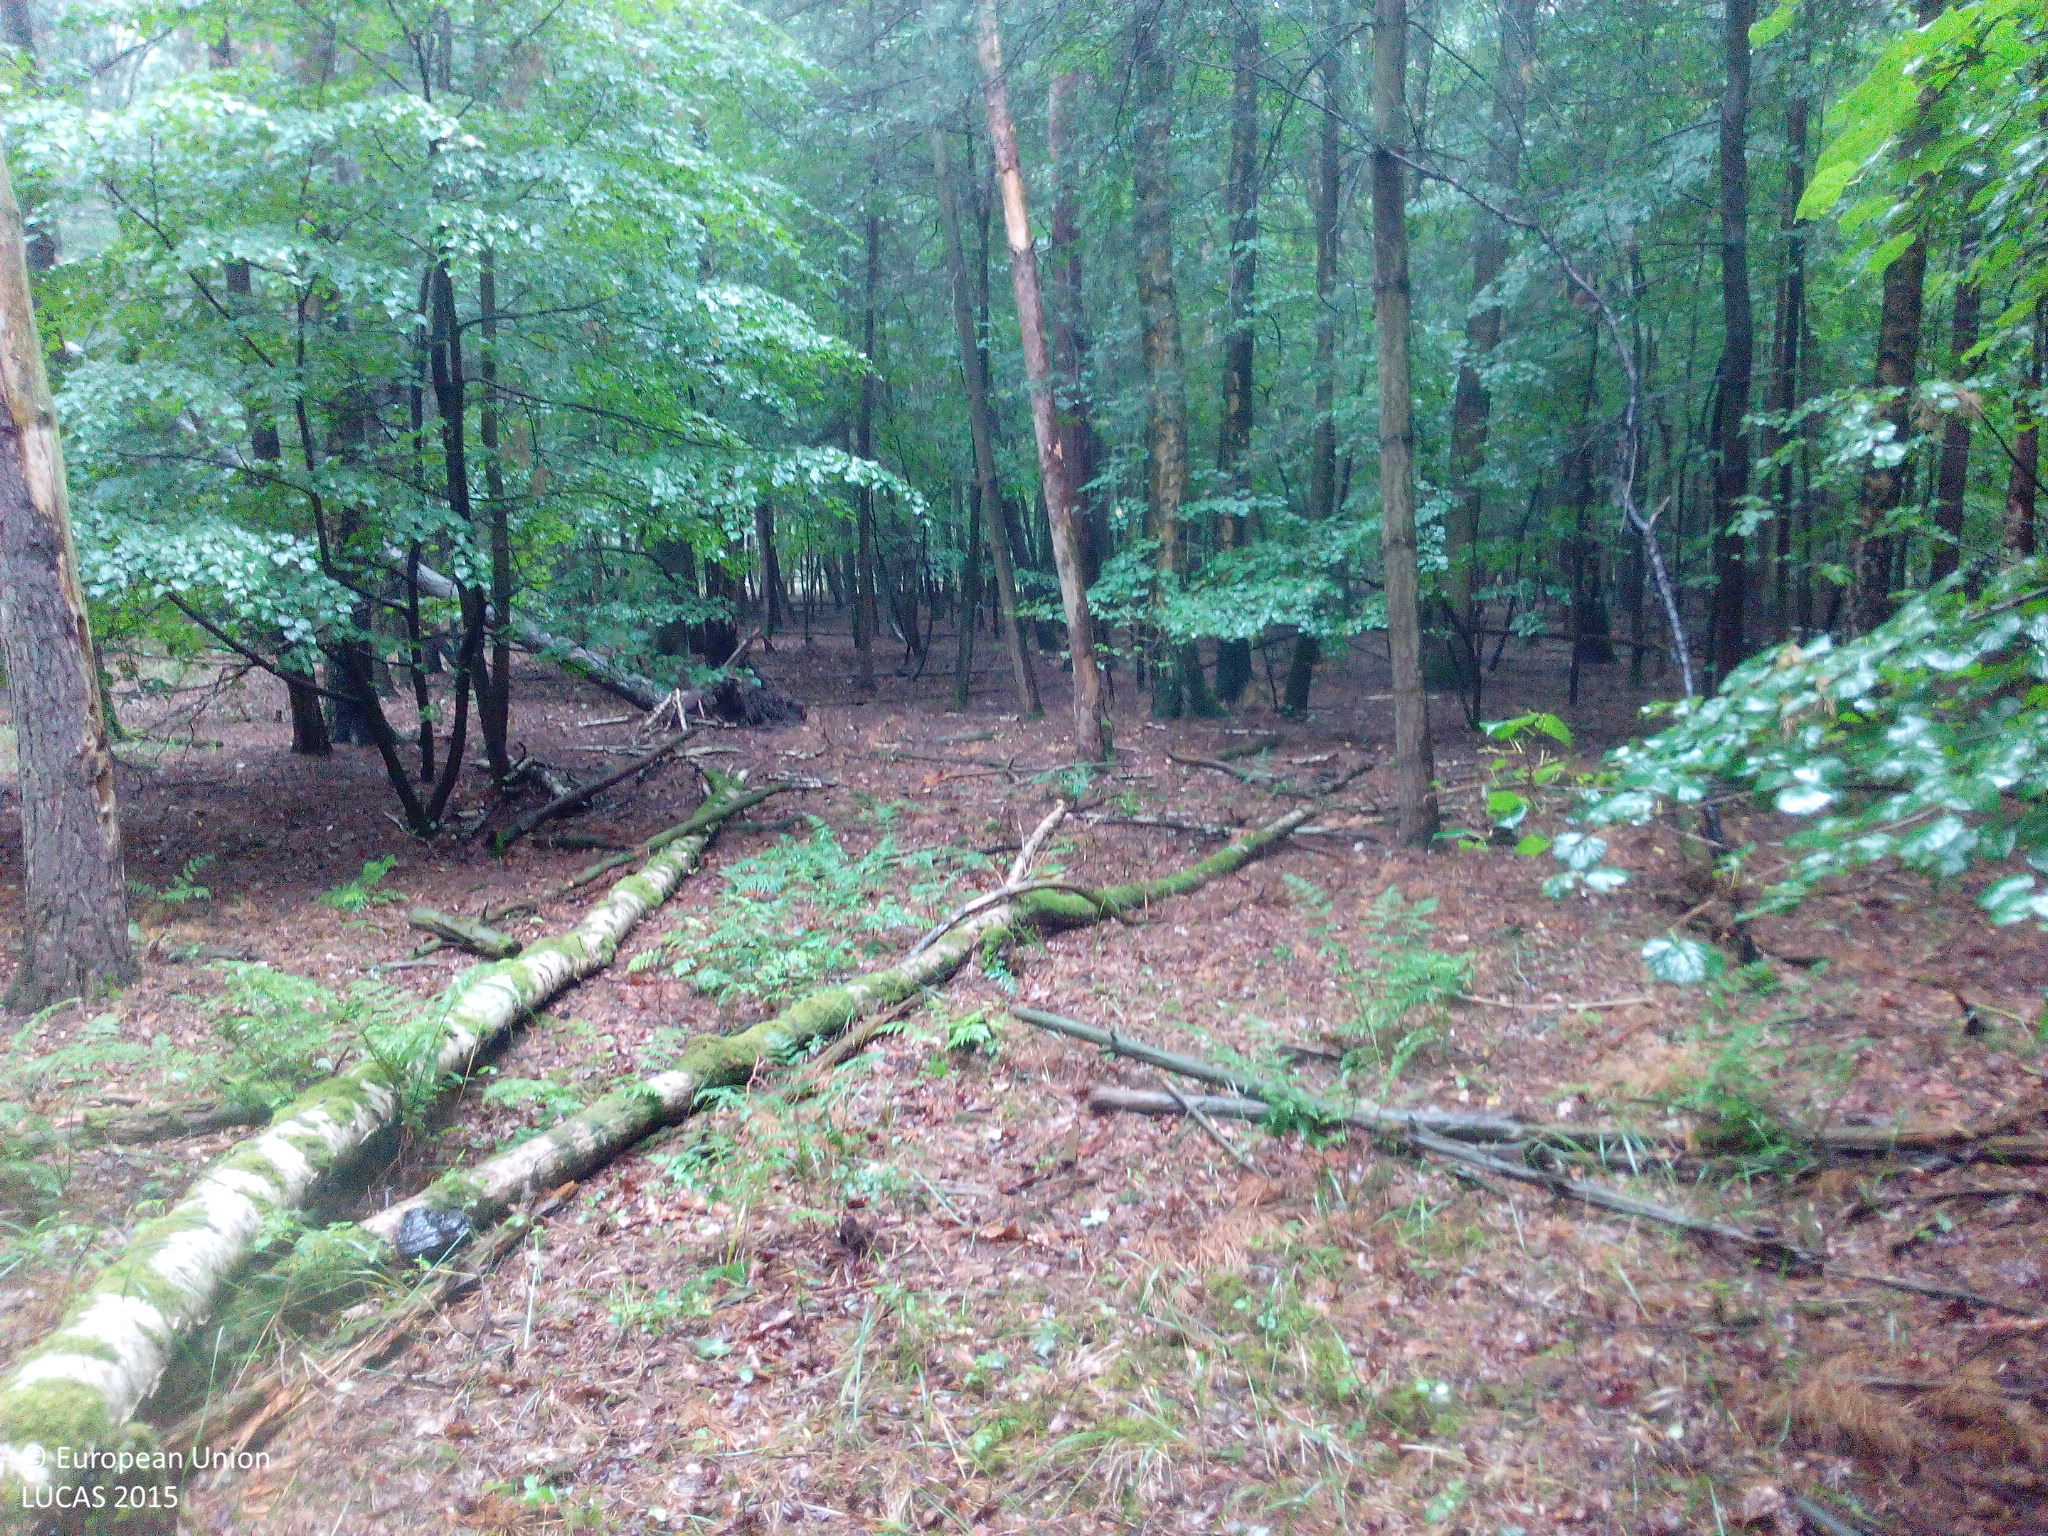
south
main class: Woodland
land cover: Pine dominated mixed woodland
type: hemiboreal forest and nemoral coniferous forest and mixed broadleaved-coniferous forest
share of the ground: > 75 %
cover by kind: coniferous forest trees 65 %, broadleaved forest trees 25 %, herbaceous plants 5 %, lichens and mosses 5 %
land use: Forestry
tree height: > 5 m
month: July
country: DE
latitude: 52.5869
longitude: 13.1733
